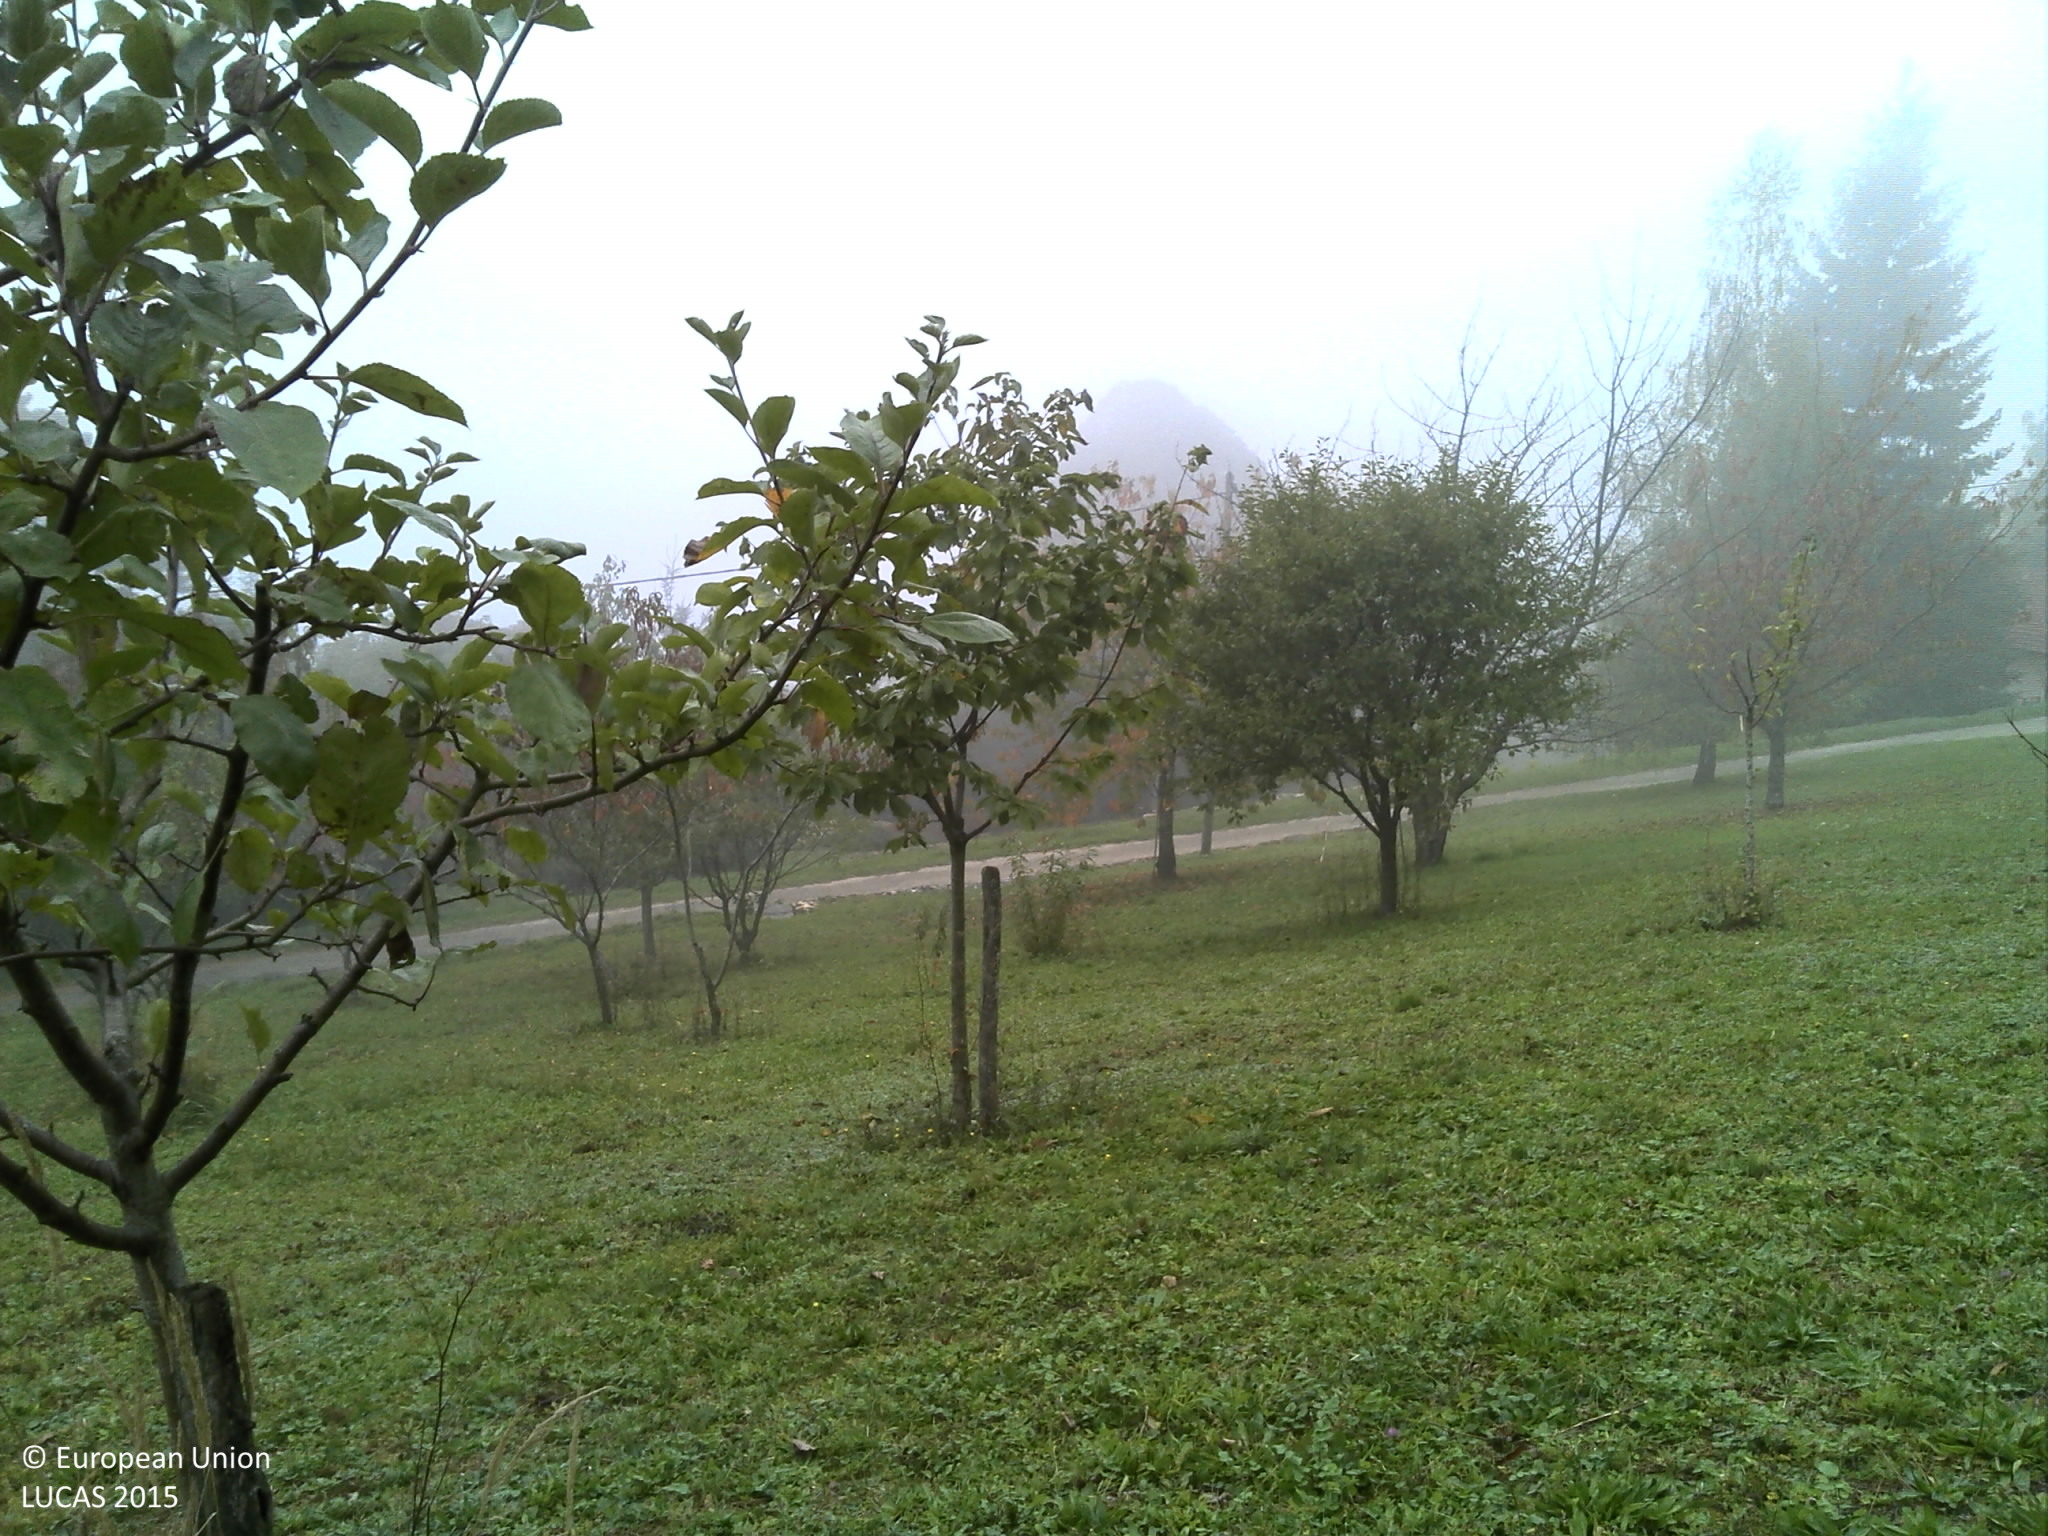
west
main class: Cropland
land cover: Apple fruit
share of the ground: 10 - 25 %
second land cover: Grassland without tree/shrub cover
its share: > 75 %
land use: Kitchen garden
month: October
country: FR
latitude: 46.3769
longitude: 5.3614
